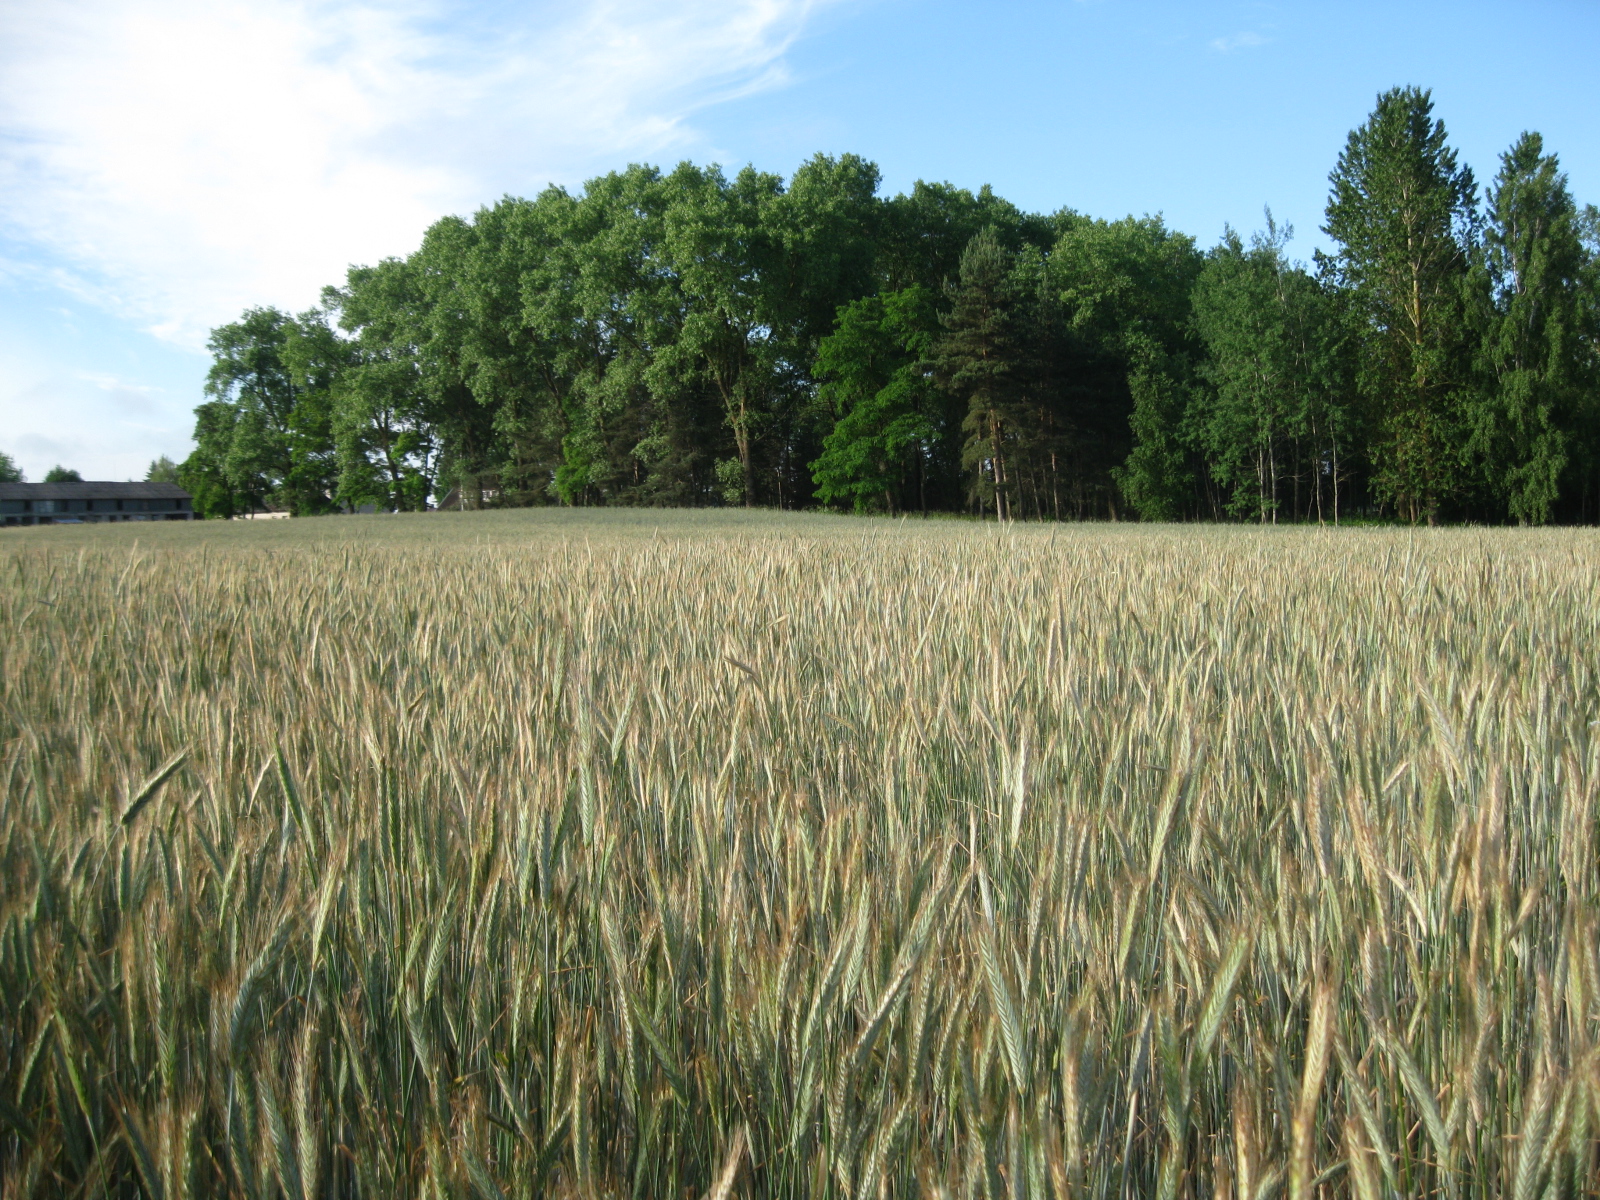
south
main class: Cropland
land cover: Rye
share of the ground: > 75 %
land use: Agriculture (excluding fallow land and kitchen gardens)
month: June
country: LT
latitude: 55.2387
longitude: 24.1046
